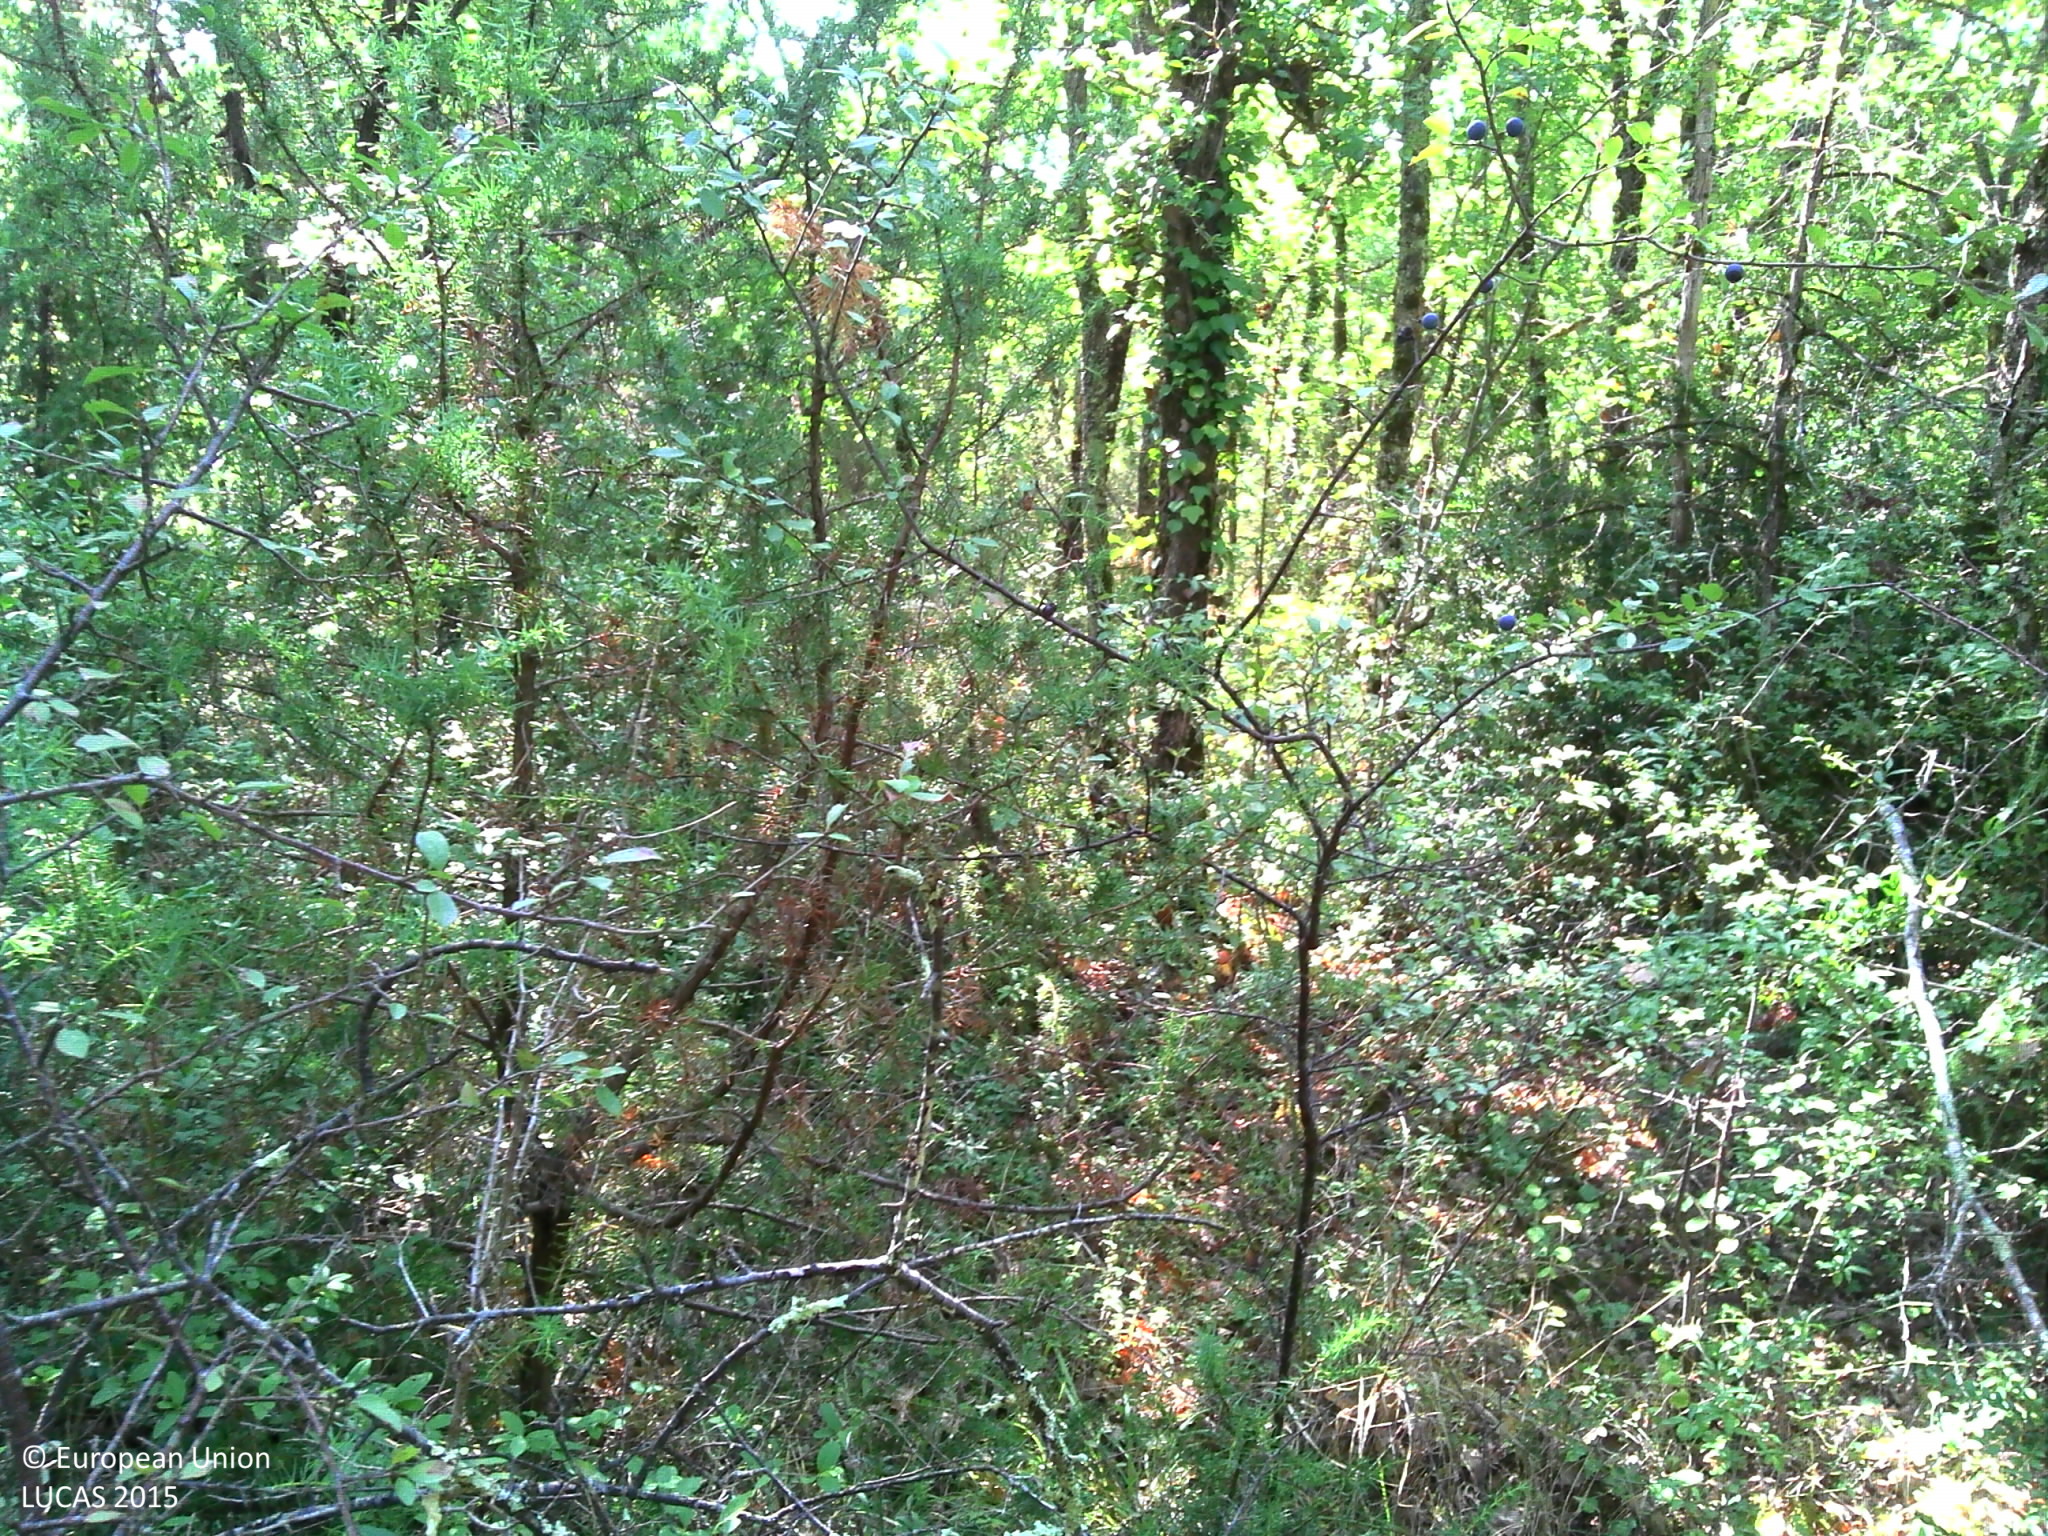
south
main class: Woodland
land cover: Broadleaved woodland
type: mesophytic deciduous forest
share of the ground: > 75 %
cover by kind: broadleaved forest trees 90 %, coniferous forest trees 10 %
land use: Agriculture (excluding fallow land and kitchen gardens)
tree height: > 5 m
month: August
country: FR
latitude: 44.2490
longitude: 1.6471
